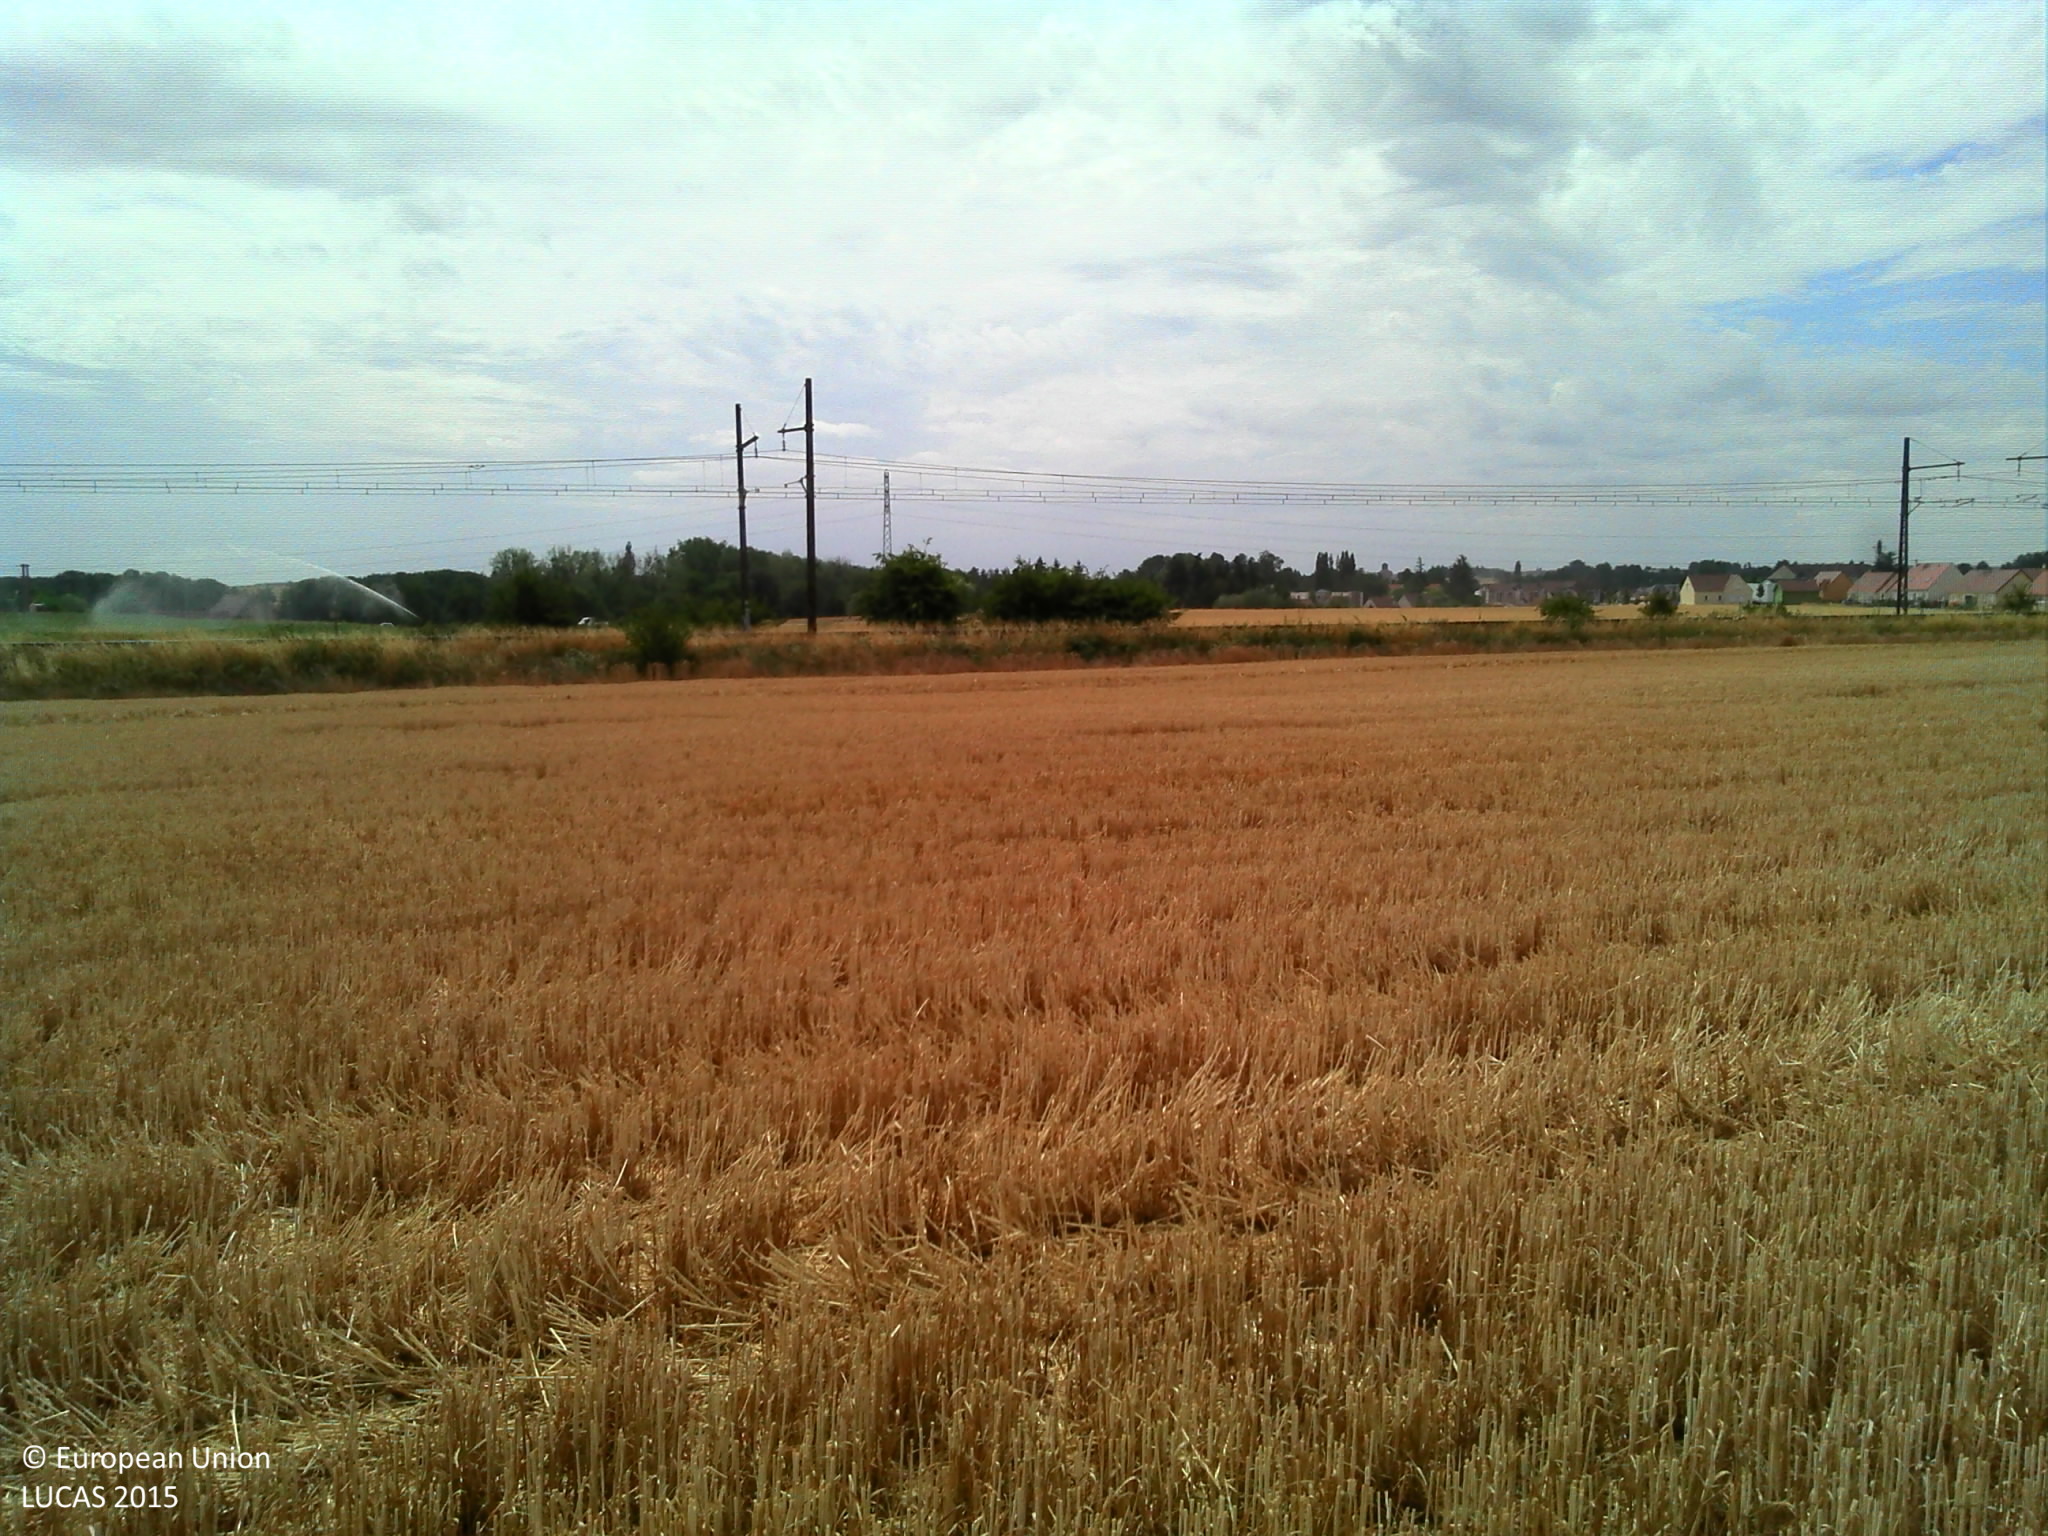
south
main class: Cropland
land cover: Common wheat
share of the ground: > 75 %
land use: Agriculture (excluding fallow land and kitchen gardens)
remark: Harvested field
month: July
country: FR
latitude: 48.4550
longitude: 1.2600
